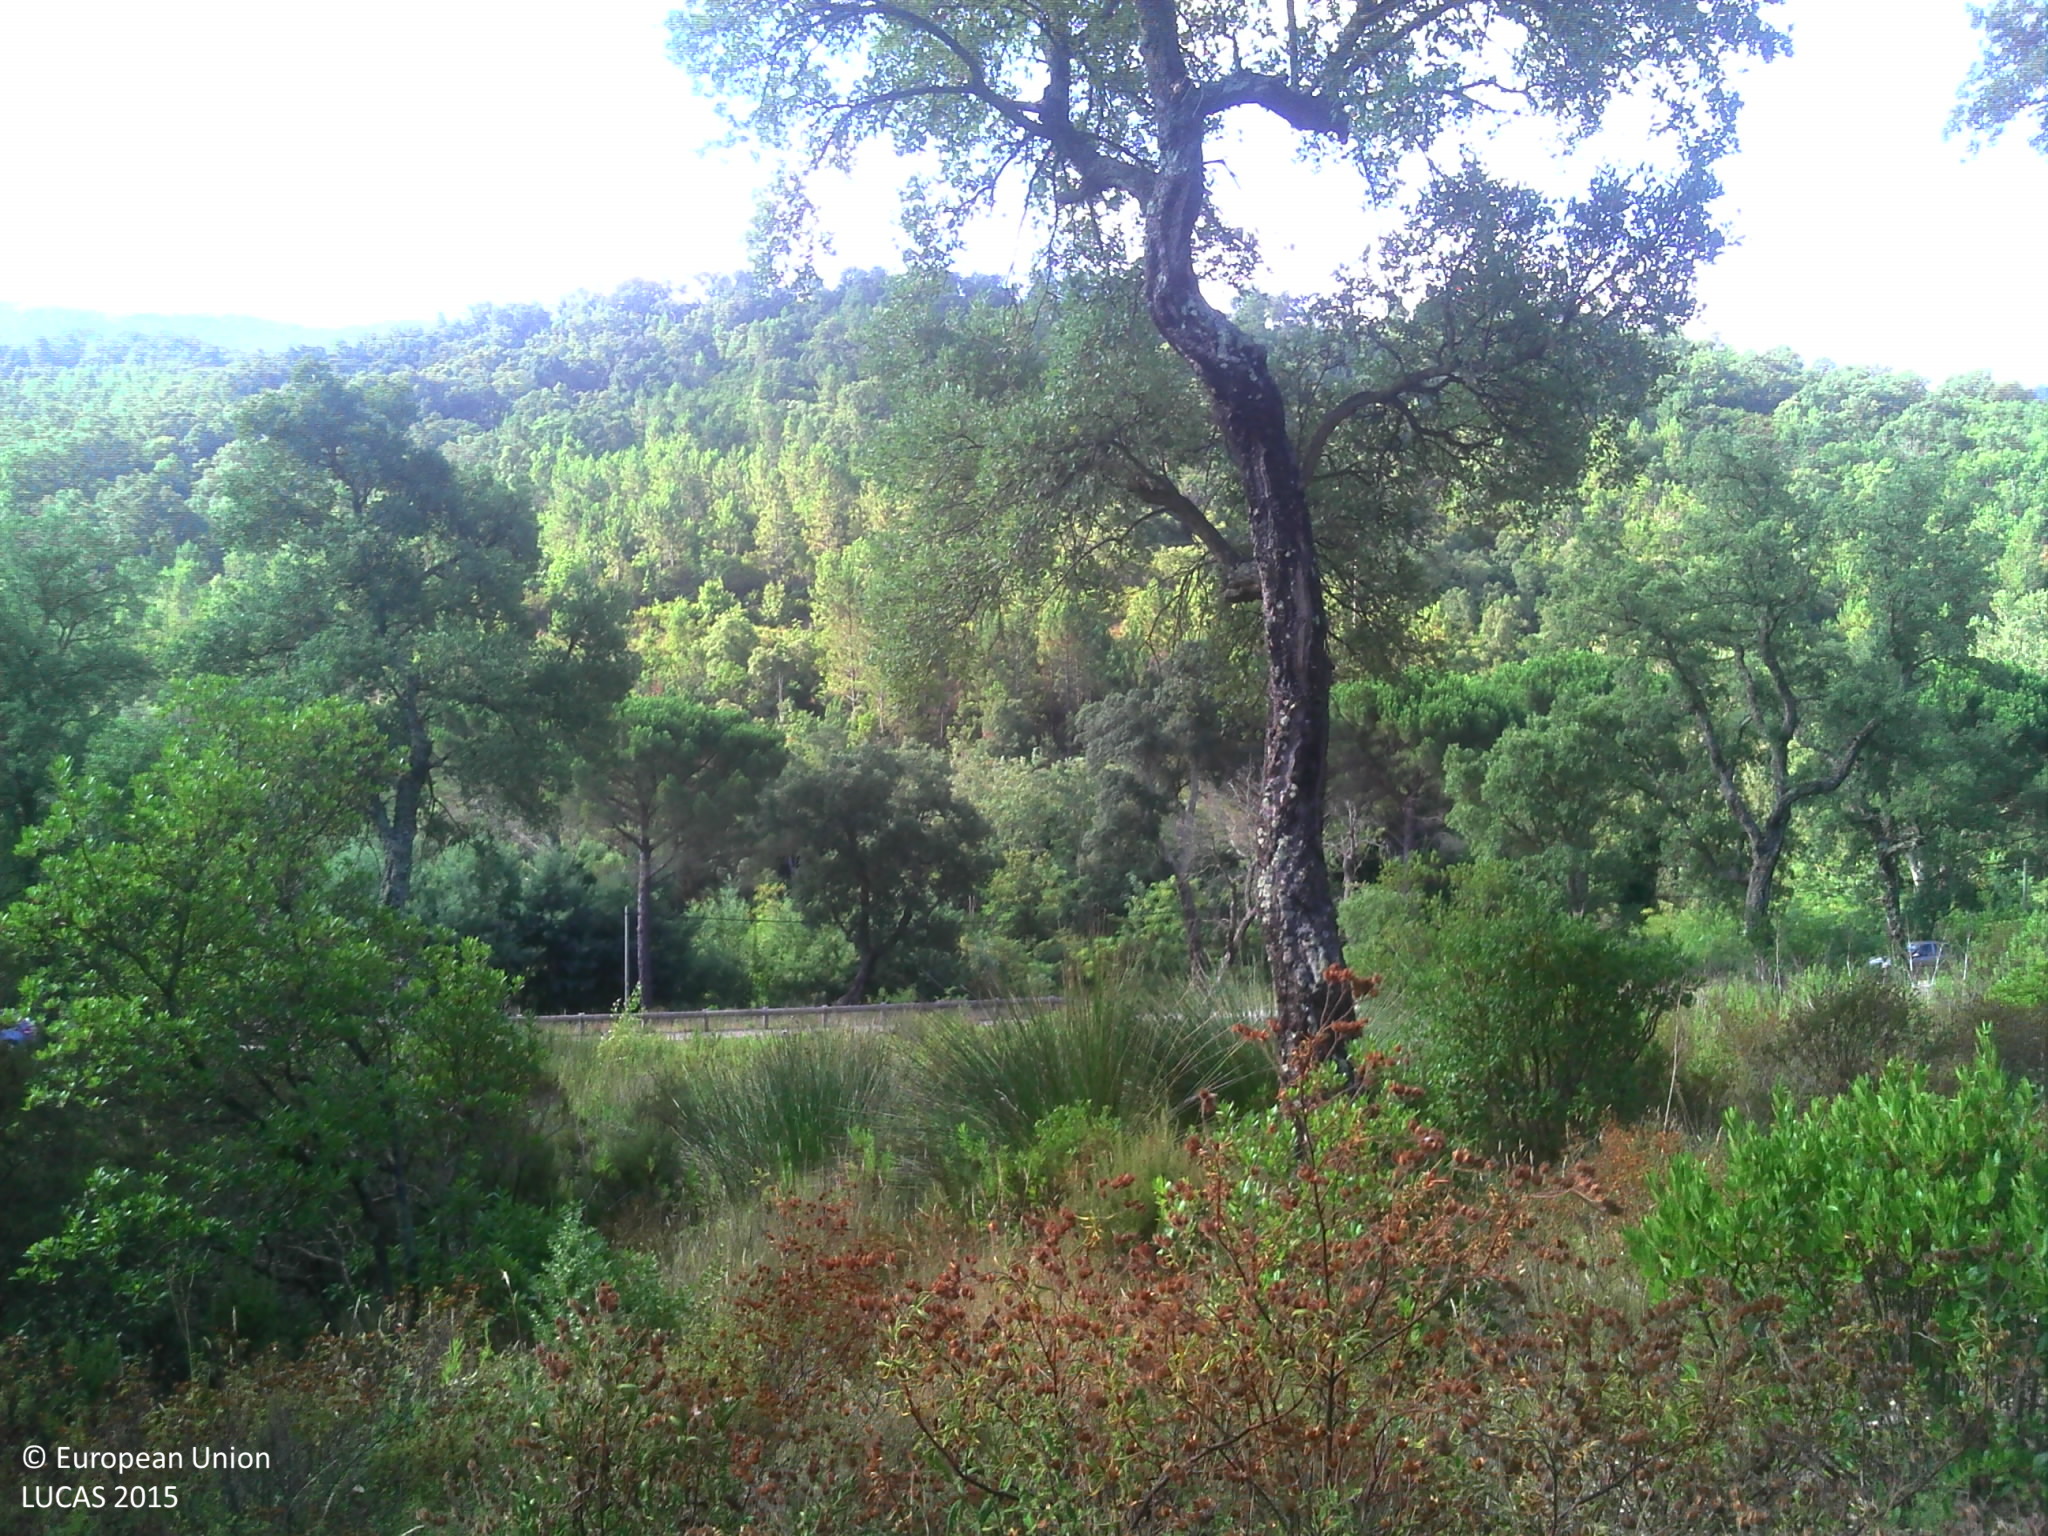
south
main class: Shrubland
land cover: Shrubland with sparse tree cover
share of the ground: > 75 %
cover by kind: shrubs 90 %, broadleaved forest trees 5 %, unconsolidated bare surface 5 %
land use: Semi-natural and natural areas not in use
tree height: < 5 m
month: July
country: FR
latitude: 43.1849
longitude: 6.3553
